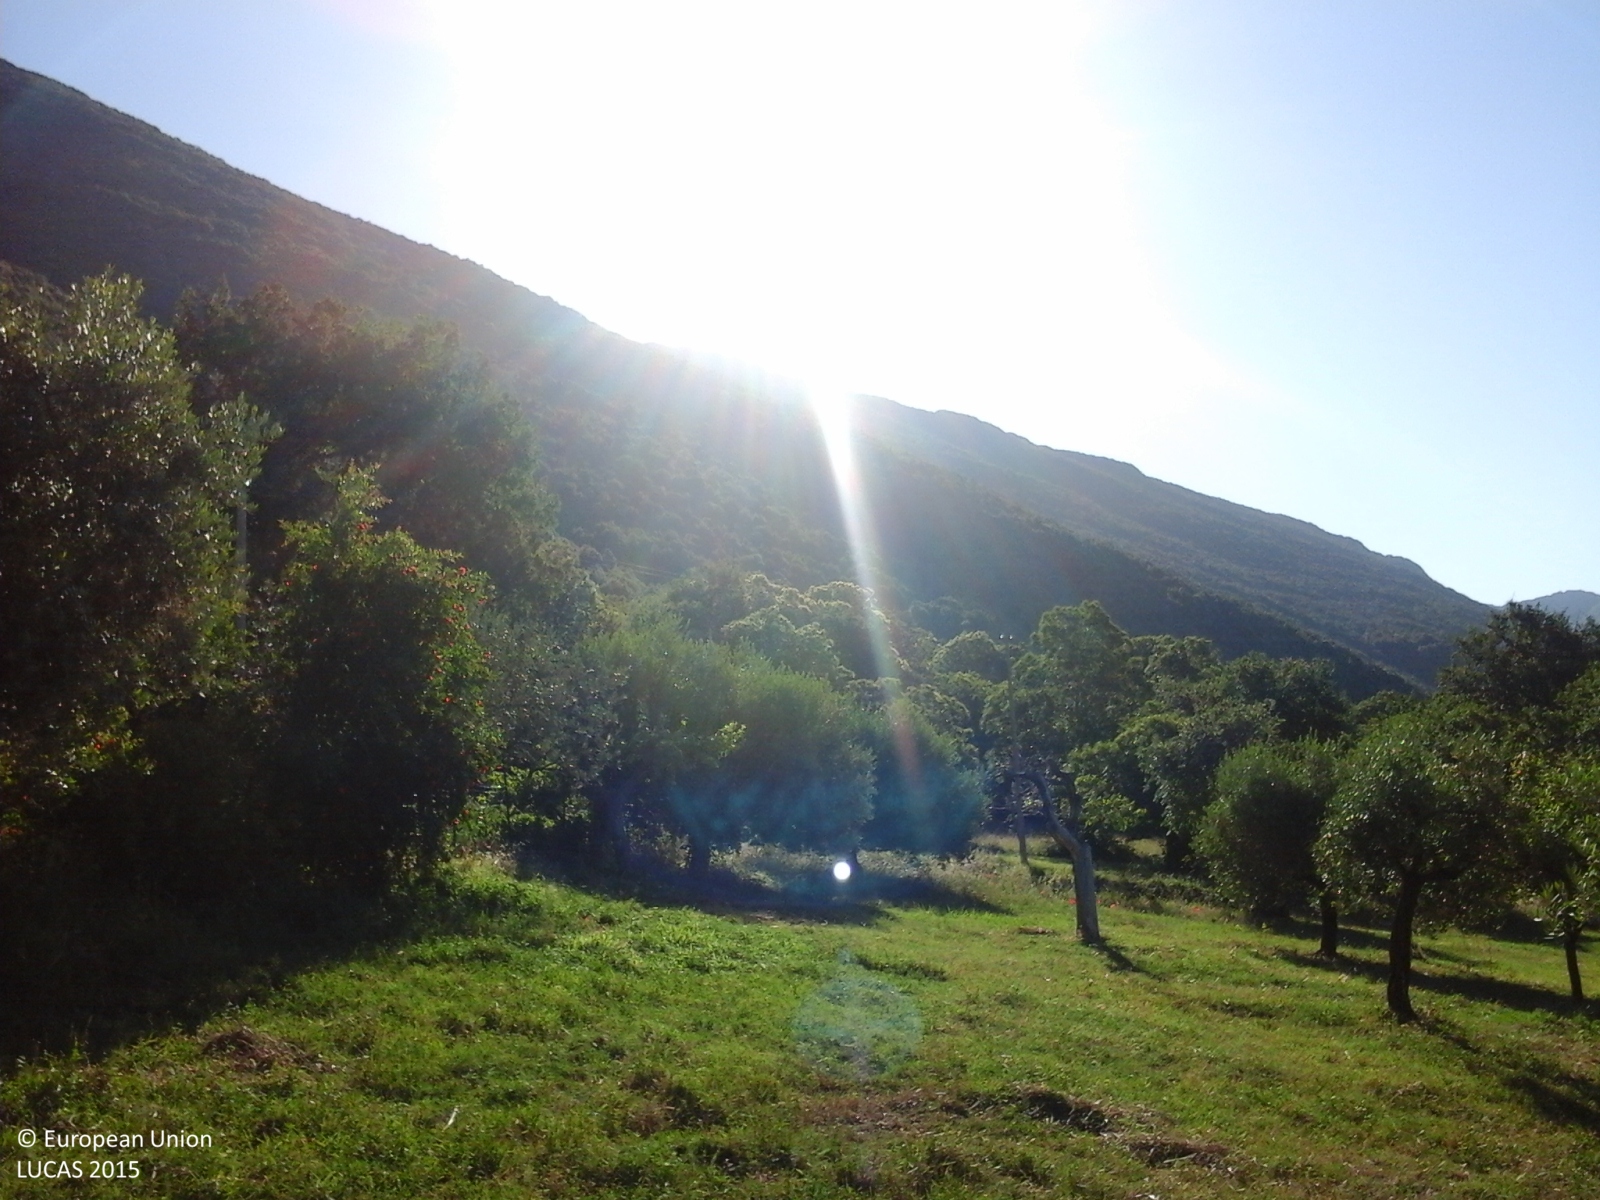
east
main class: Woodland
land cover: Broadleaved woodland
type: thermophilous deciduous forest
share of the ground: > 75 %
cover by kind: broadleaved forest trees 100 %
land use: Forestry
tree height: > 5 m
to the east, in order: Broadleaved woodland
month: June
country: IT
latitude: 40.4245
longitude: 15.1053
